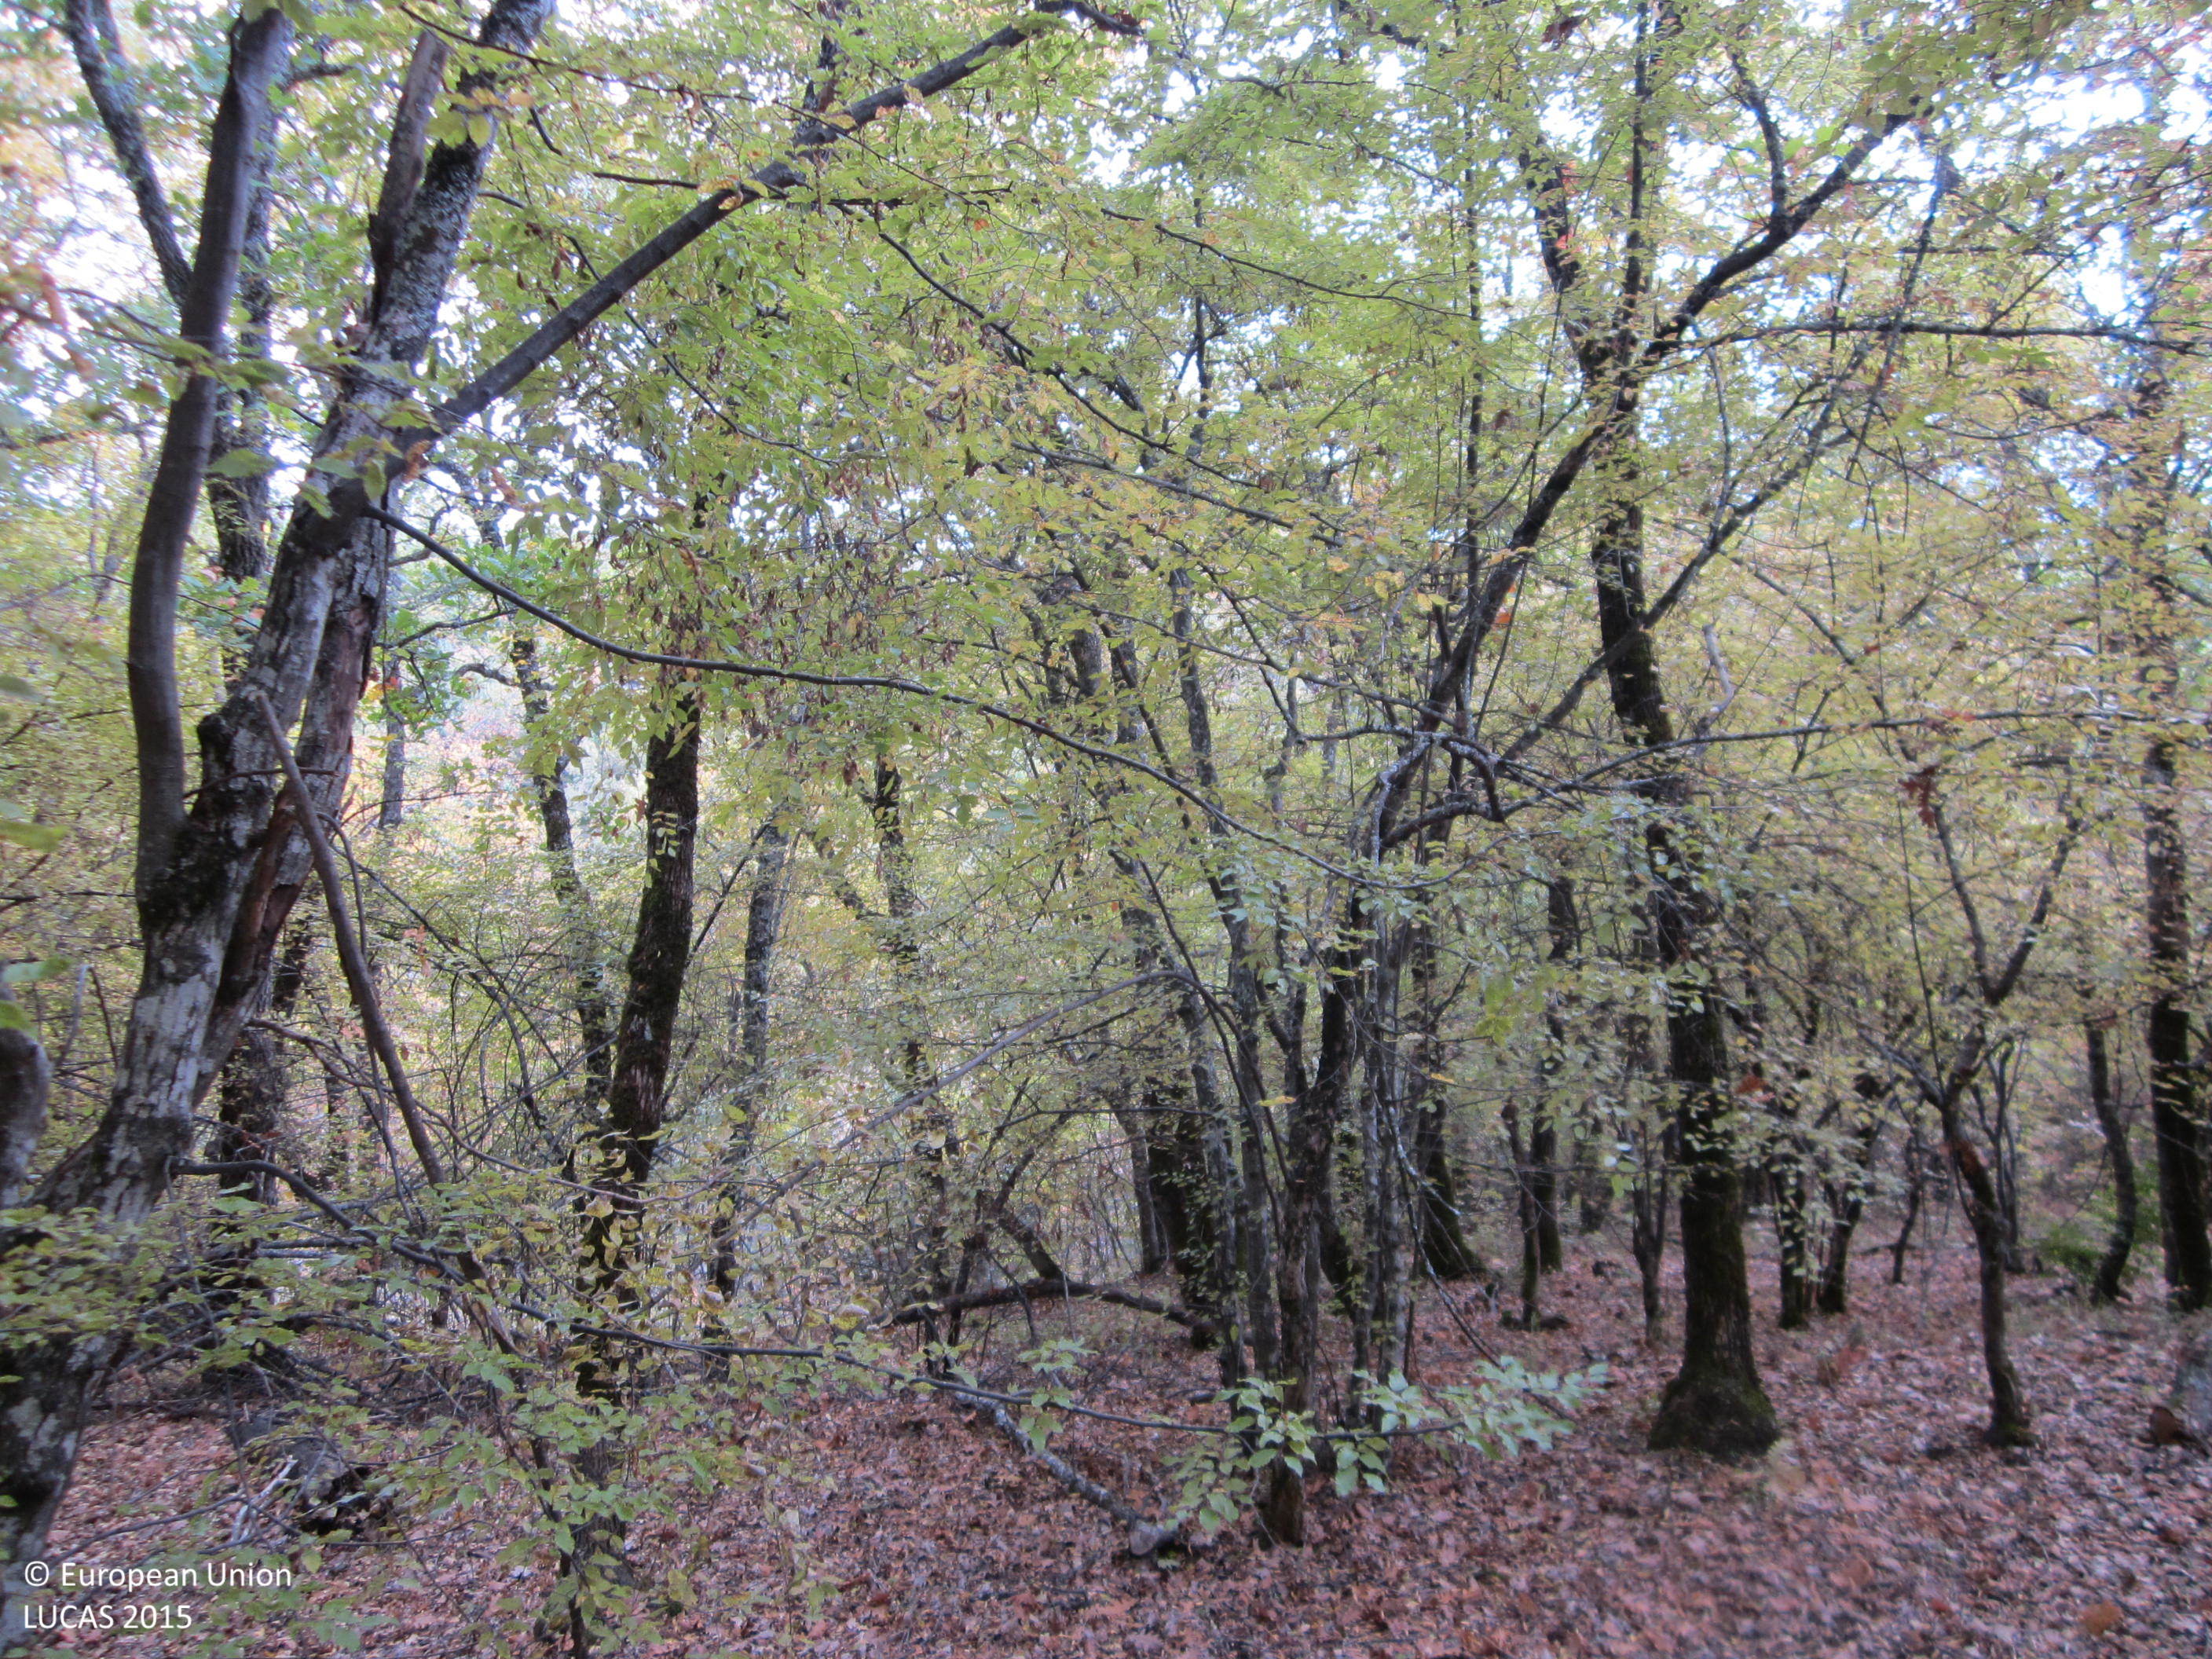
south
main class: Woodland
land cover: Broadleaved woodland
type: mesophytic deciduous forest
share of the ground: > 75 %
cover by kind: broadleaved forest trees 80 %, unconsolidated bare surface 10 %, shrubs 5 %, lichens and mosses 5 %
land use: Forestry
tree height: > 5 m
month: November
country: BG
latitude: 41.4400
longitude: 25.9235
